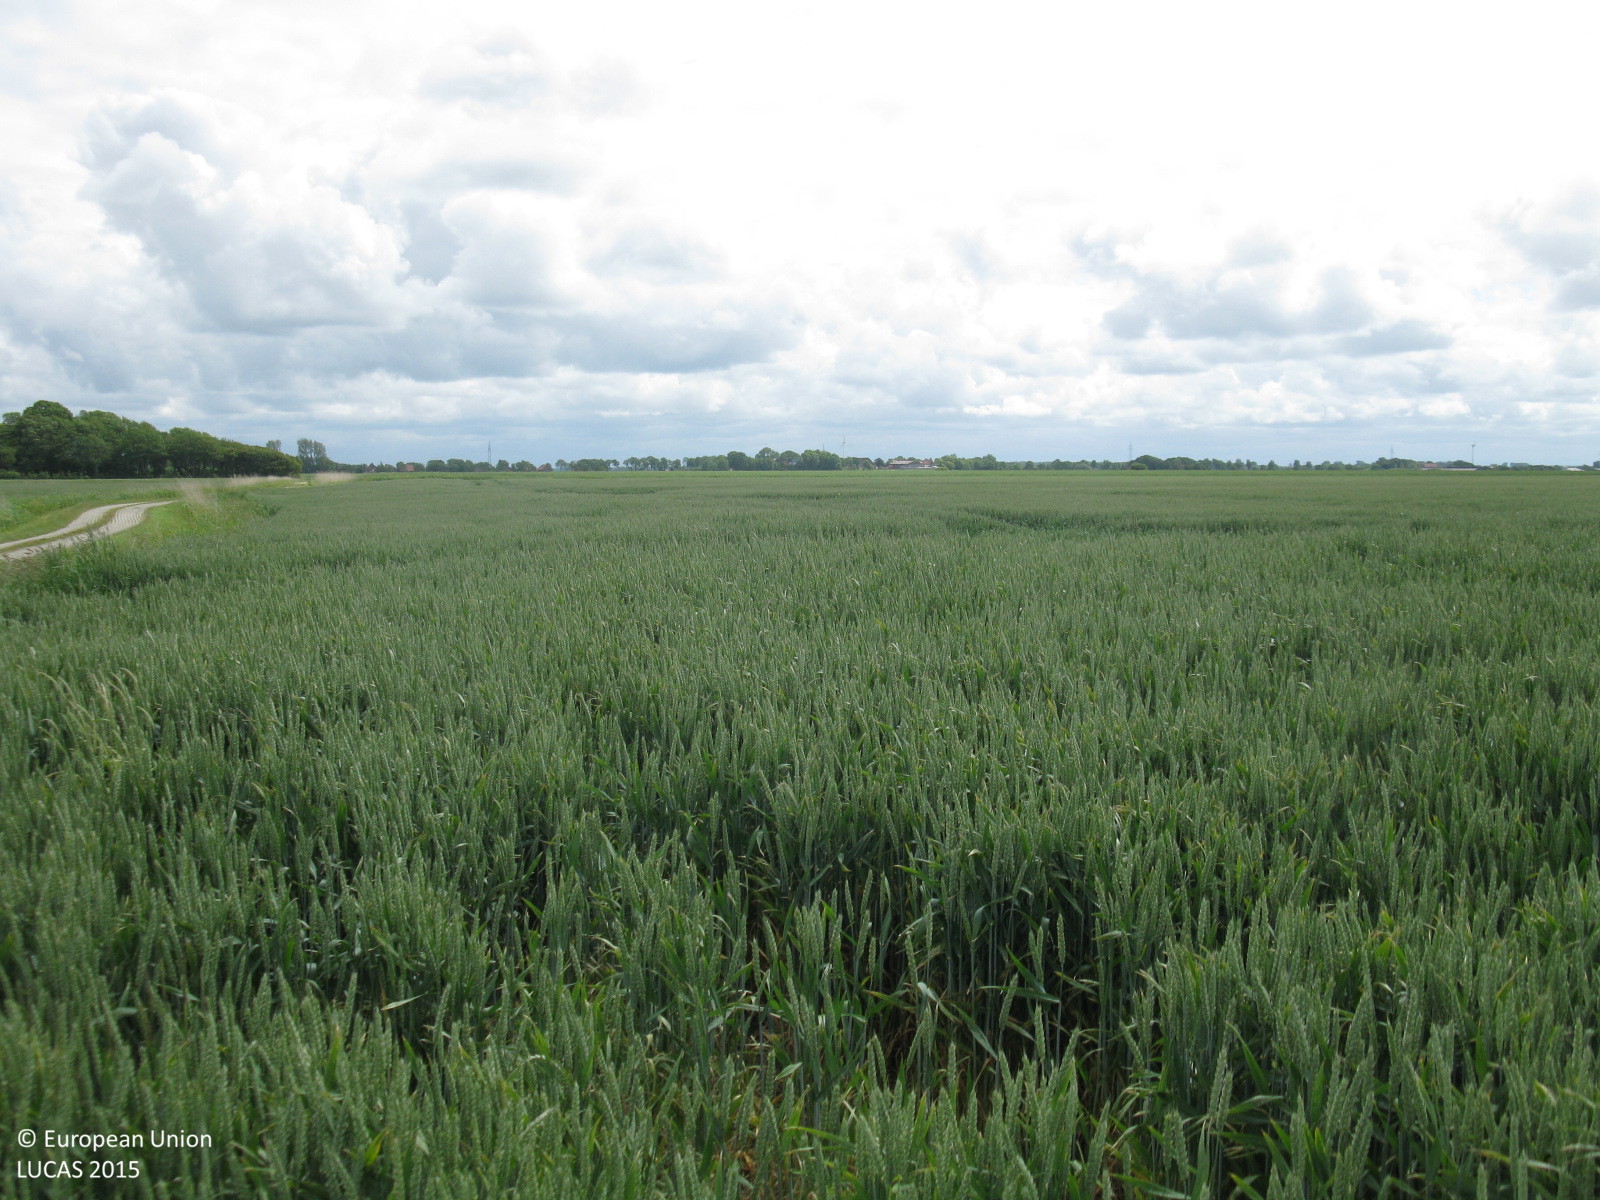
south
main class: Cropland
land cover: Barley
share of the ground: > 75 %
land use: Agriculture (excluding fallow land and kitchen gardens)
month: June
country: DE
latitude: 53.6601
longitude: 7.3223
